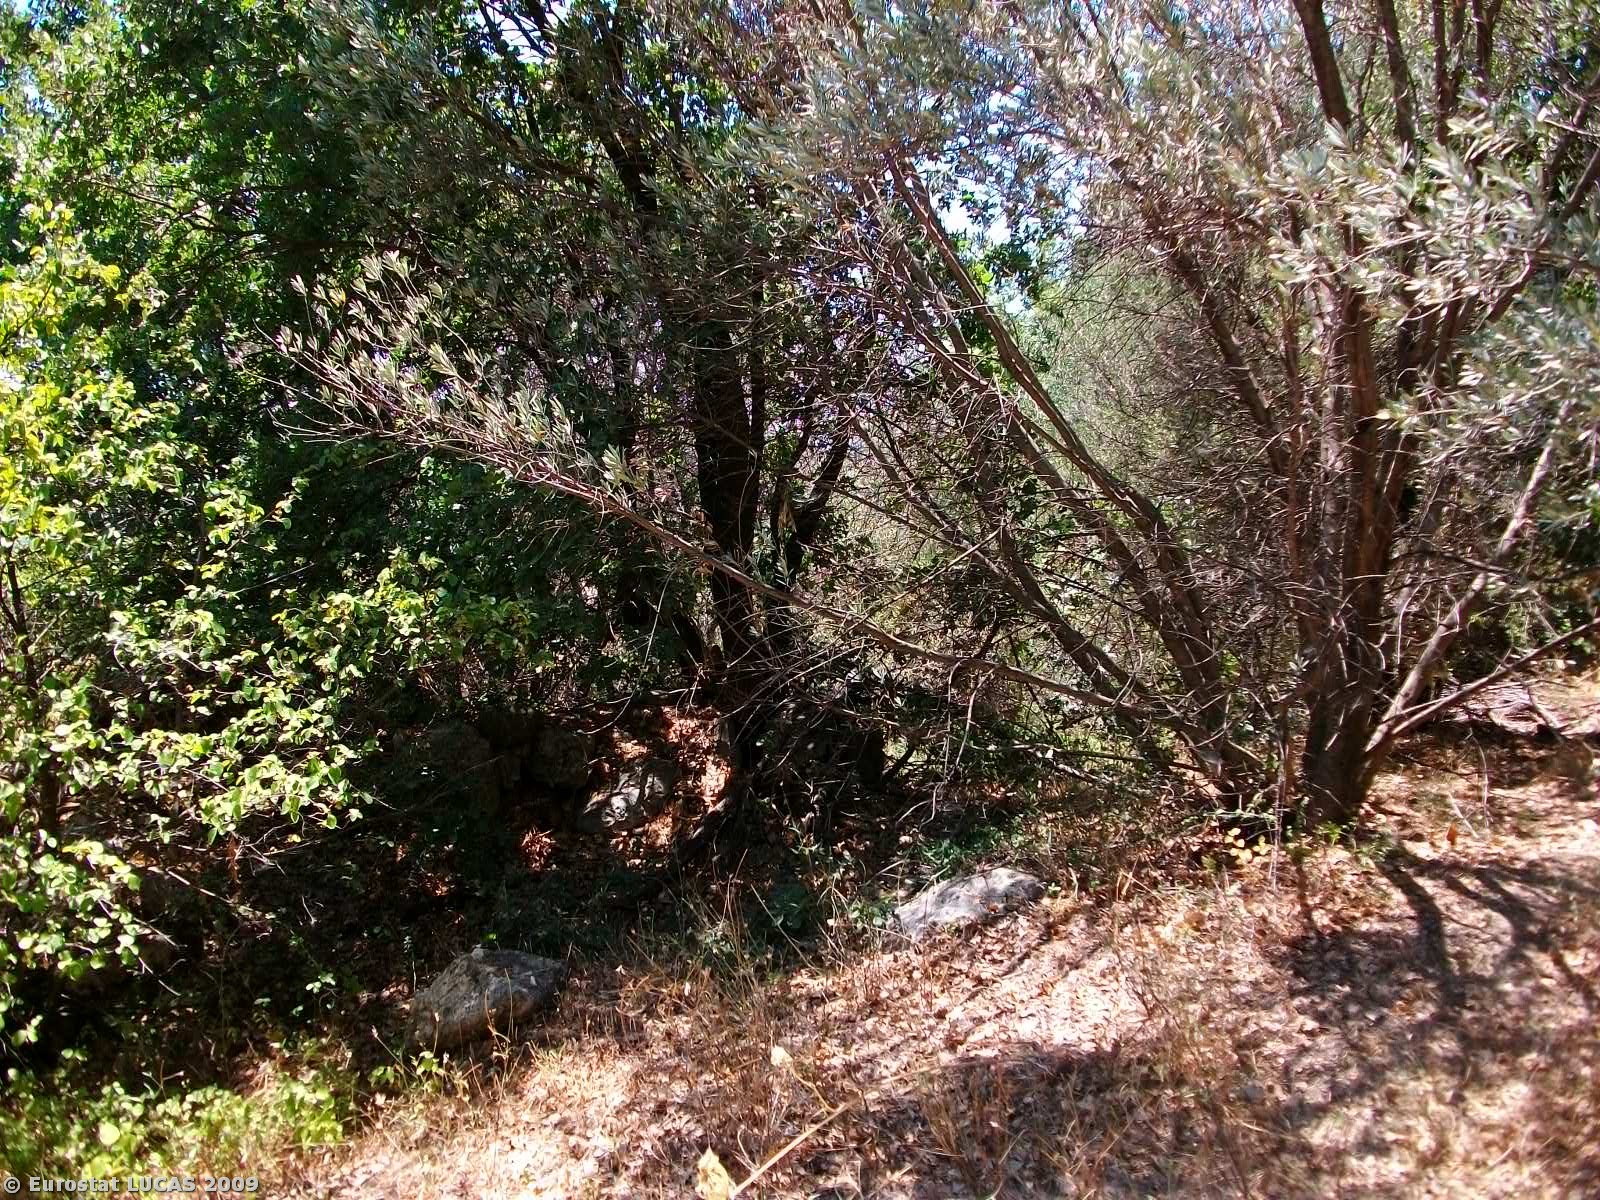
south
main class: Cropland
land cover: Olive groves
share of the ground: 50 - 75 %
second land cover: Bare land
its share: 50 - 75 %
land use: Agriculture (excluding fallow land and kitchen gardens)
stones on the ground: 10 - 25 %
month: May
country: GR
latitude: 35.2438
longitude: 24.9905
